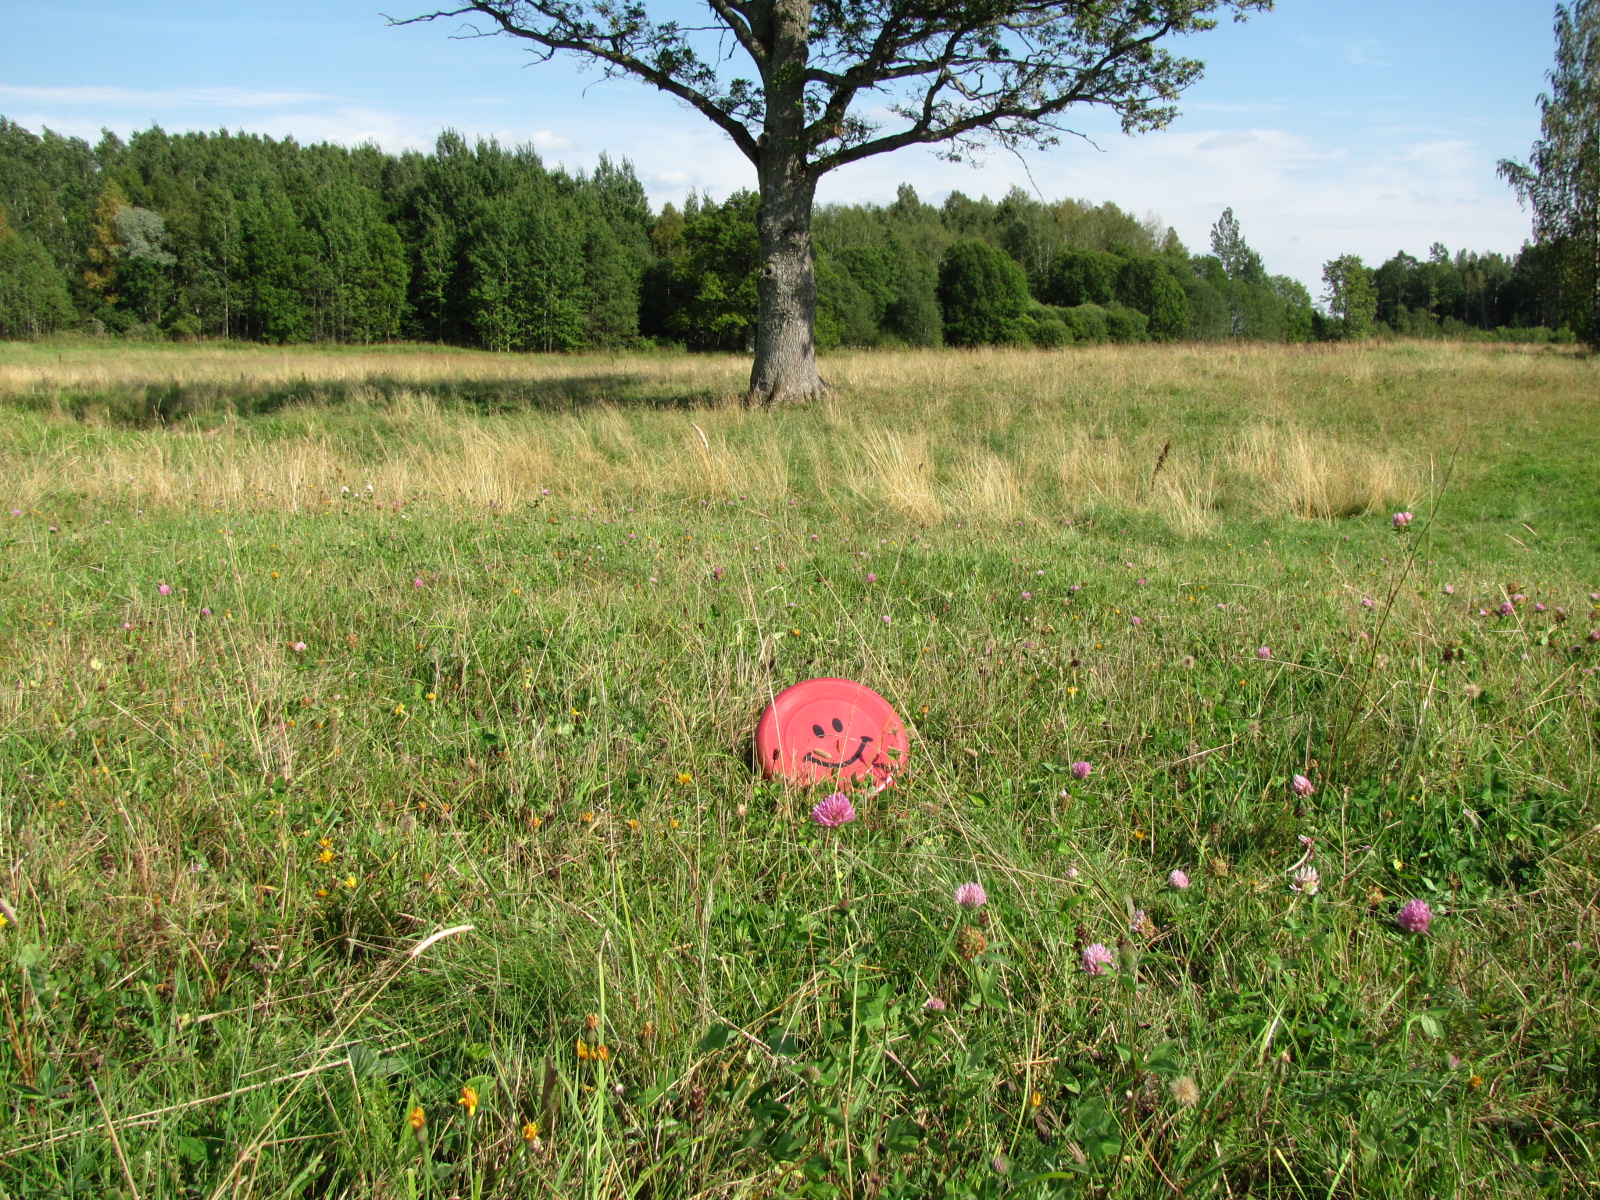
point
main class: Grassland
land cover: Grassland without tree/shrub cover
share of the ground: > 75 %
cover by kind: herbaceous plants 100 %
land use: Agriculture (excluding fallow land and kitchen gardens)
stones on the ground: < 10 %
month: August
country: LV
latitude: 56.9767
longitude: 25.2308
